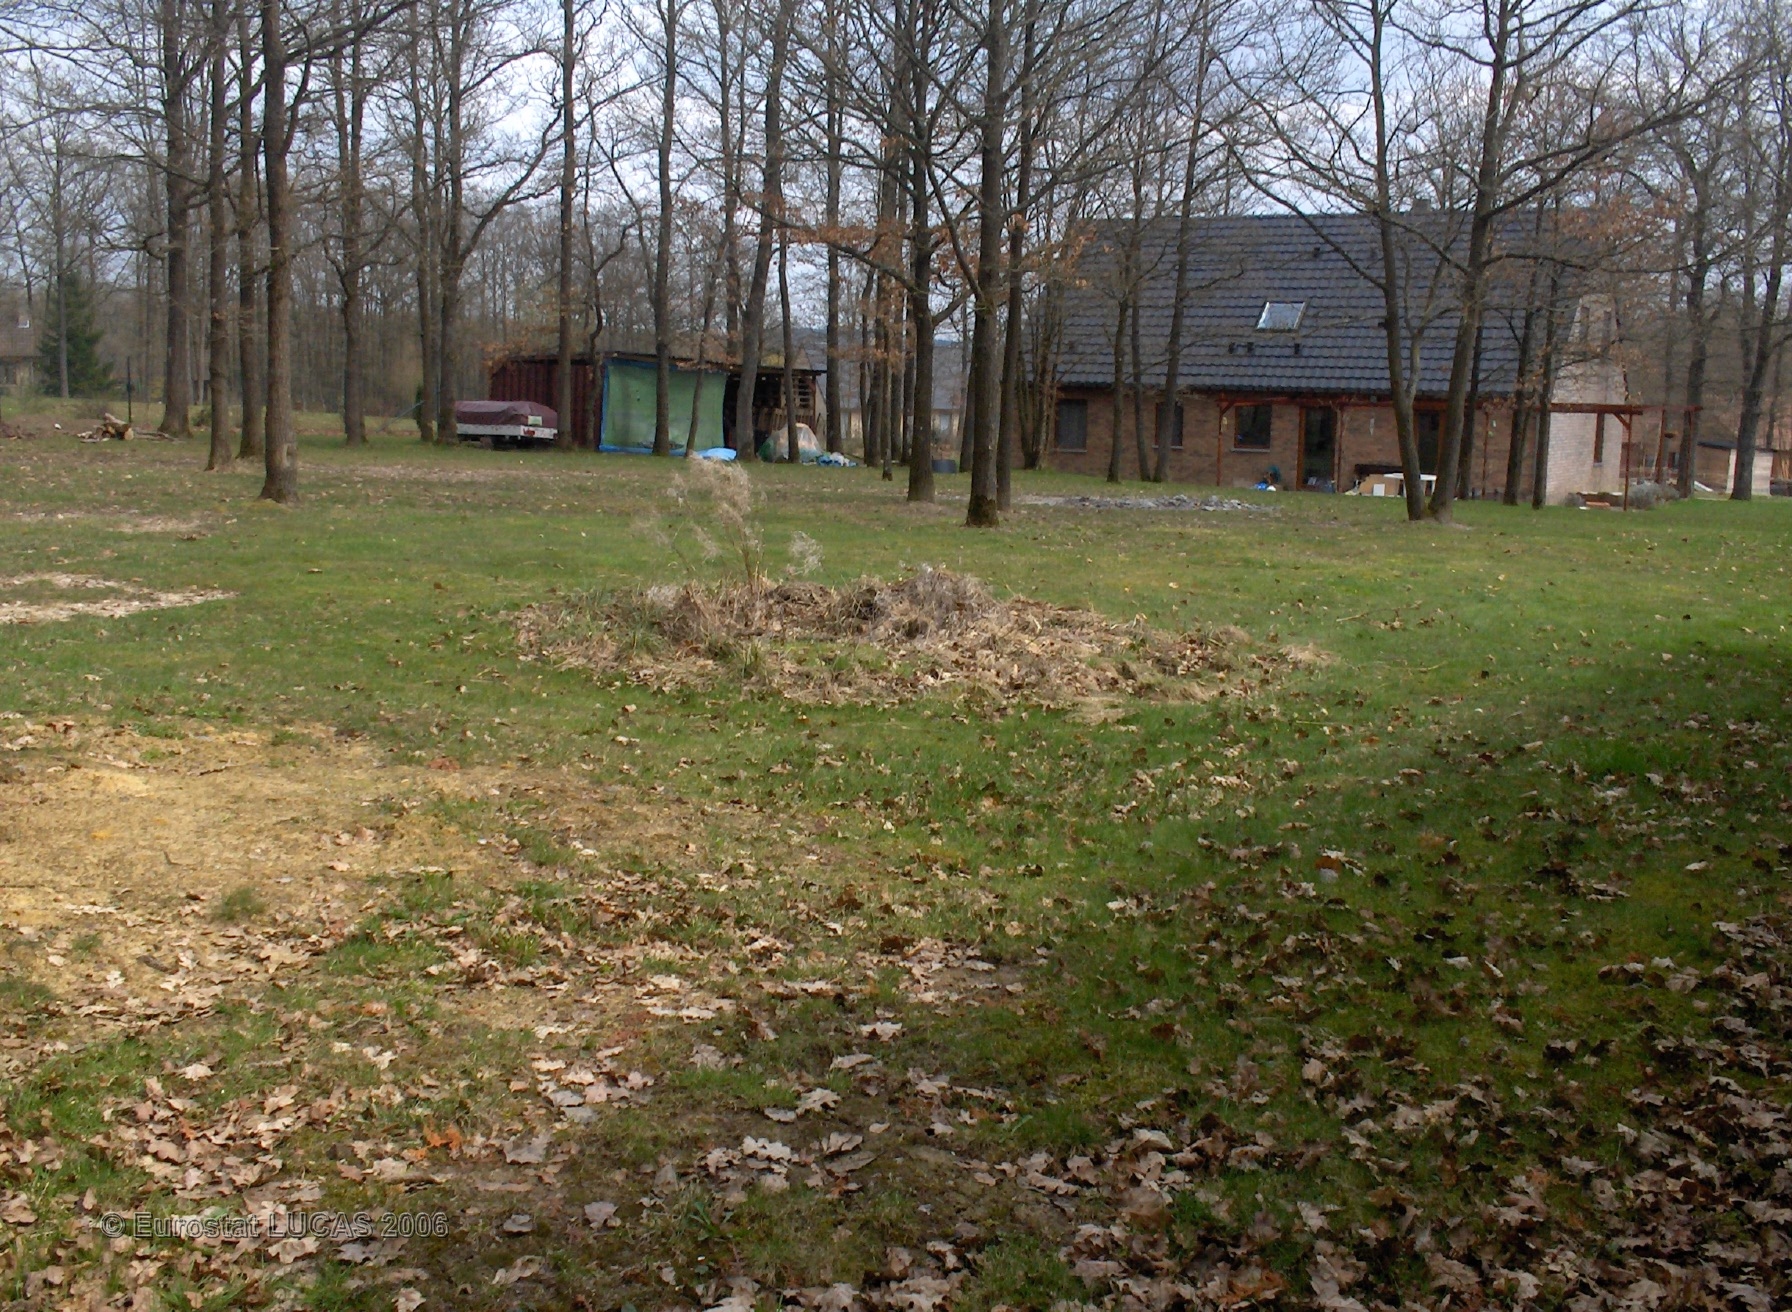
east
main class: Woodland
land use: Residential
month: April
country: BE
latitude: 50.1070
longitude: 4.5290
